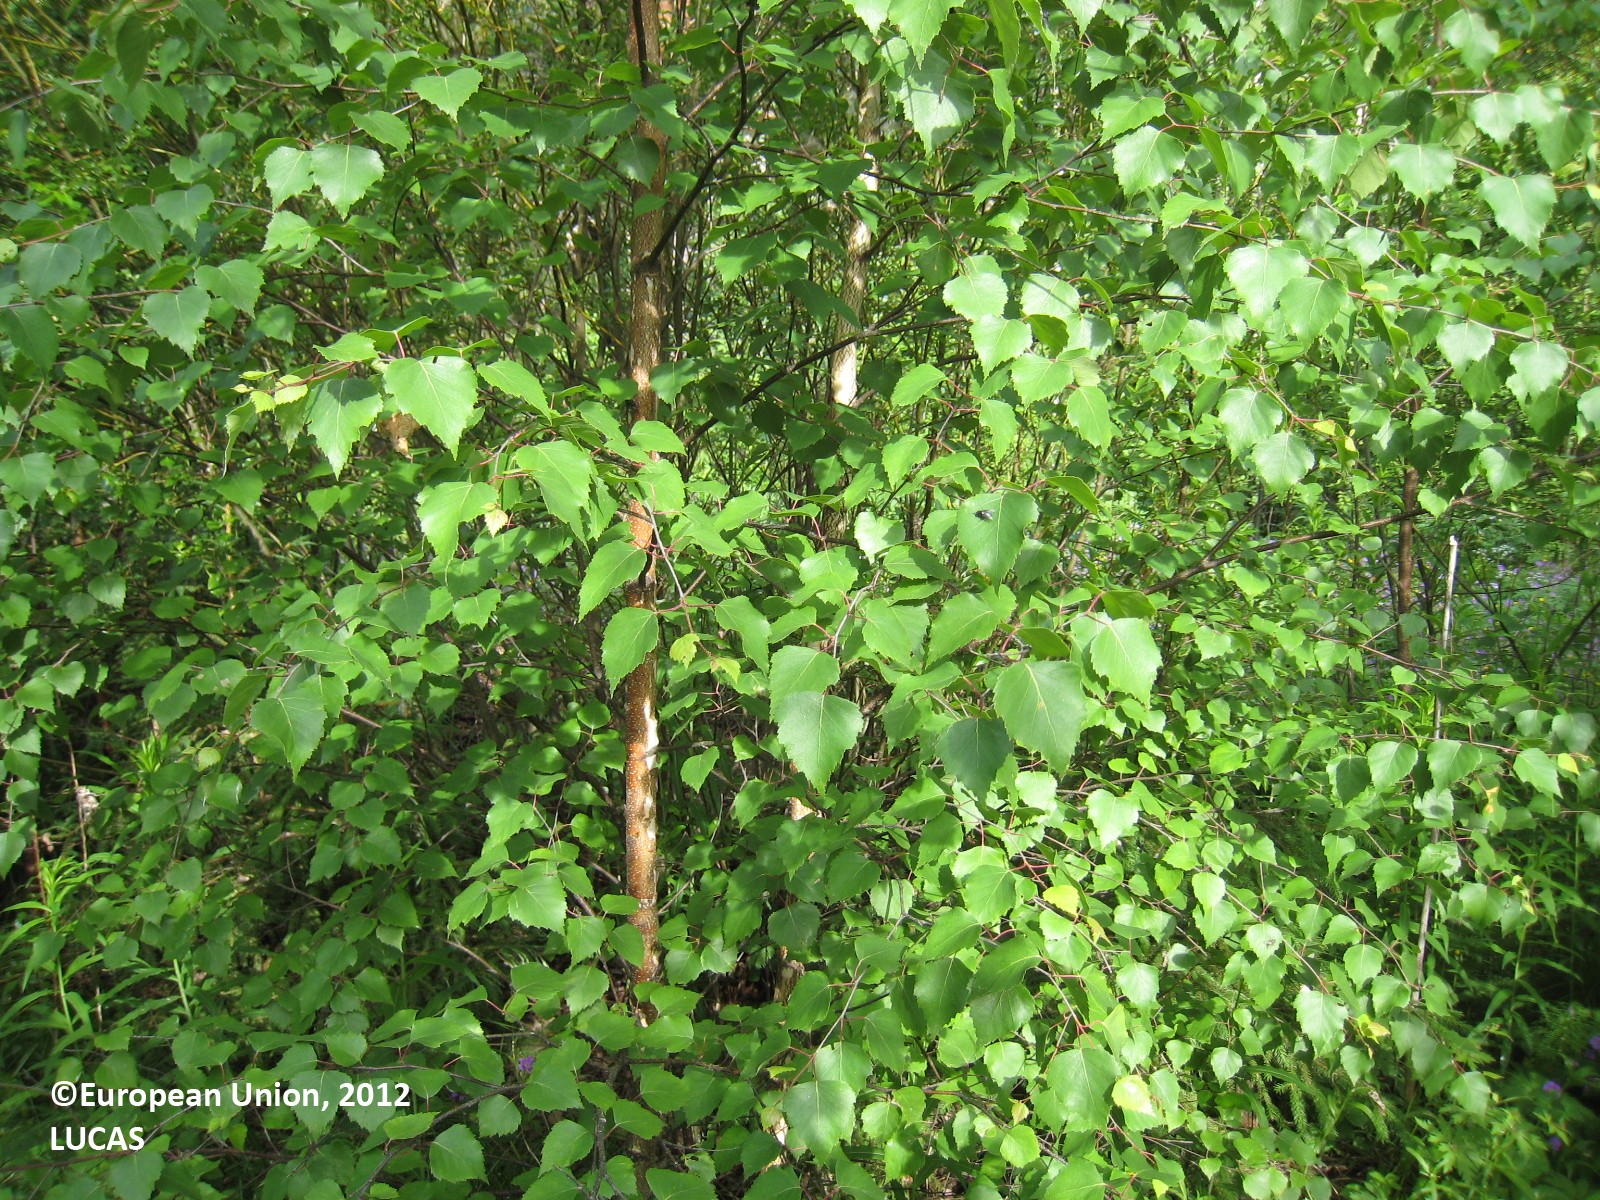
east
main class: Woodland
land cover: Broadleaved woodland
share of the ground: > 75 %
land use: Semi-natural and natural areas not in use
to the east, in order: Broadleaved woodland; Grassland without tree/shrub cover; Other mixed woodland; Ditches and canals; Spruce dominated coniferous woodland; Other coniferous woodland; Spruce dominated coniferous woodland; Other mixed woodland; Spruce dominated mixed woodland; Ditches and canals; Other bare soil; Tracks; Pine dominated coniferous woodland
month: June
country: FI
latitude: 62.4545
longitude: 25.9596
